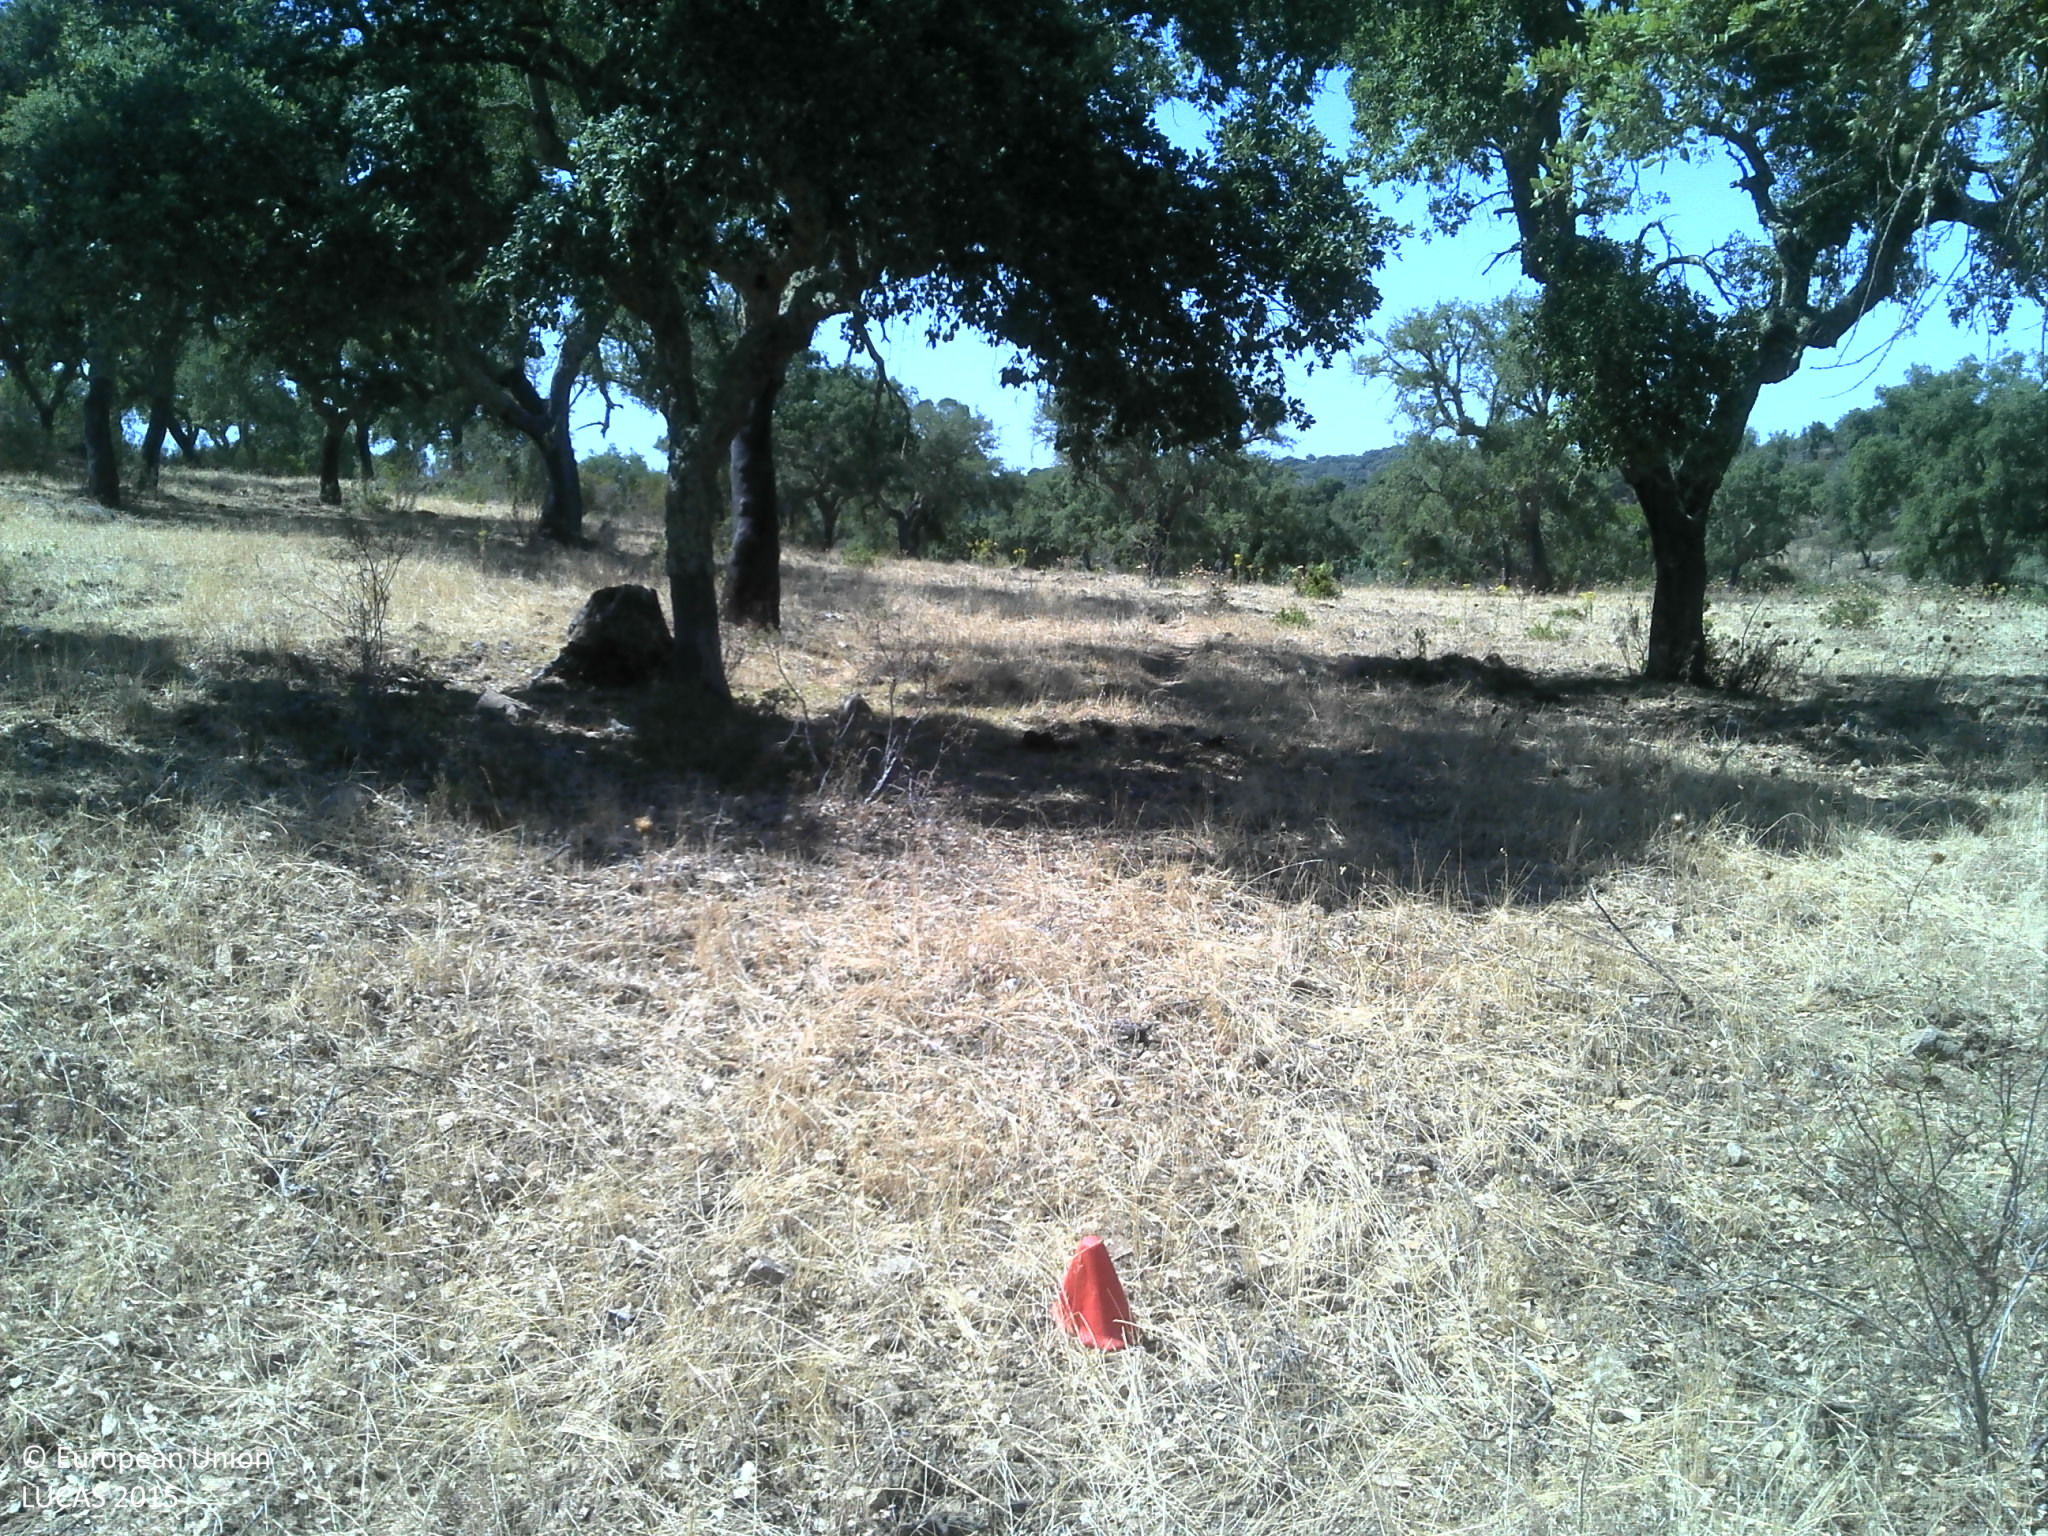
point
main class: Woodland
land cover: Broadleaved woodland
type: broadleaved evergreen forest
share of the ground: 25 - 50 %
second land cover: Grassland without tree/shrub cover
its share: 25 - 50 %
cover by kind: broadleaved forest trees 40 %, unconsolidated bare surface 35 %, herbaceous plants 25 %
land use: Forestry
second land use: Agriculture (excluding fallow land and kitchen gardens)
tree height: > 5 m
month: July
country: PT
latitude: 38.9939
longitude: -8.1930
